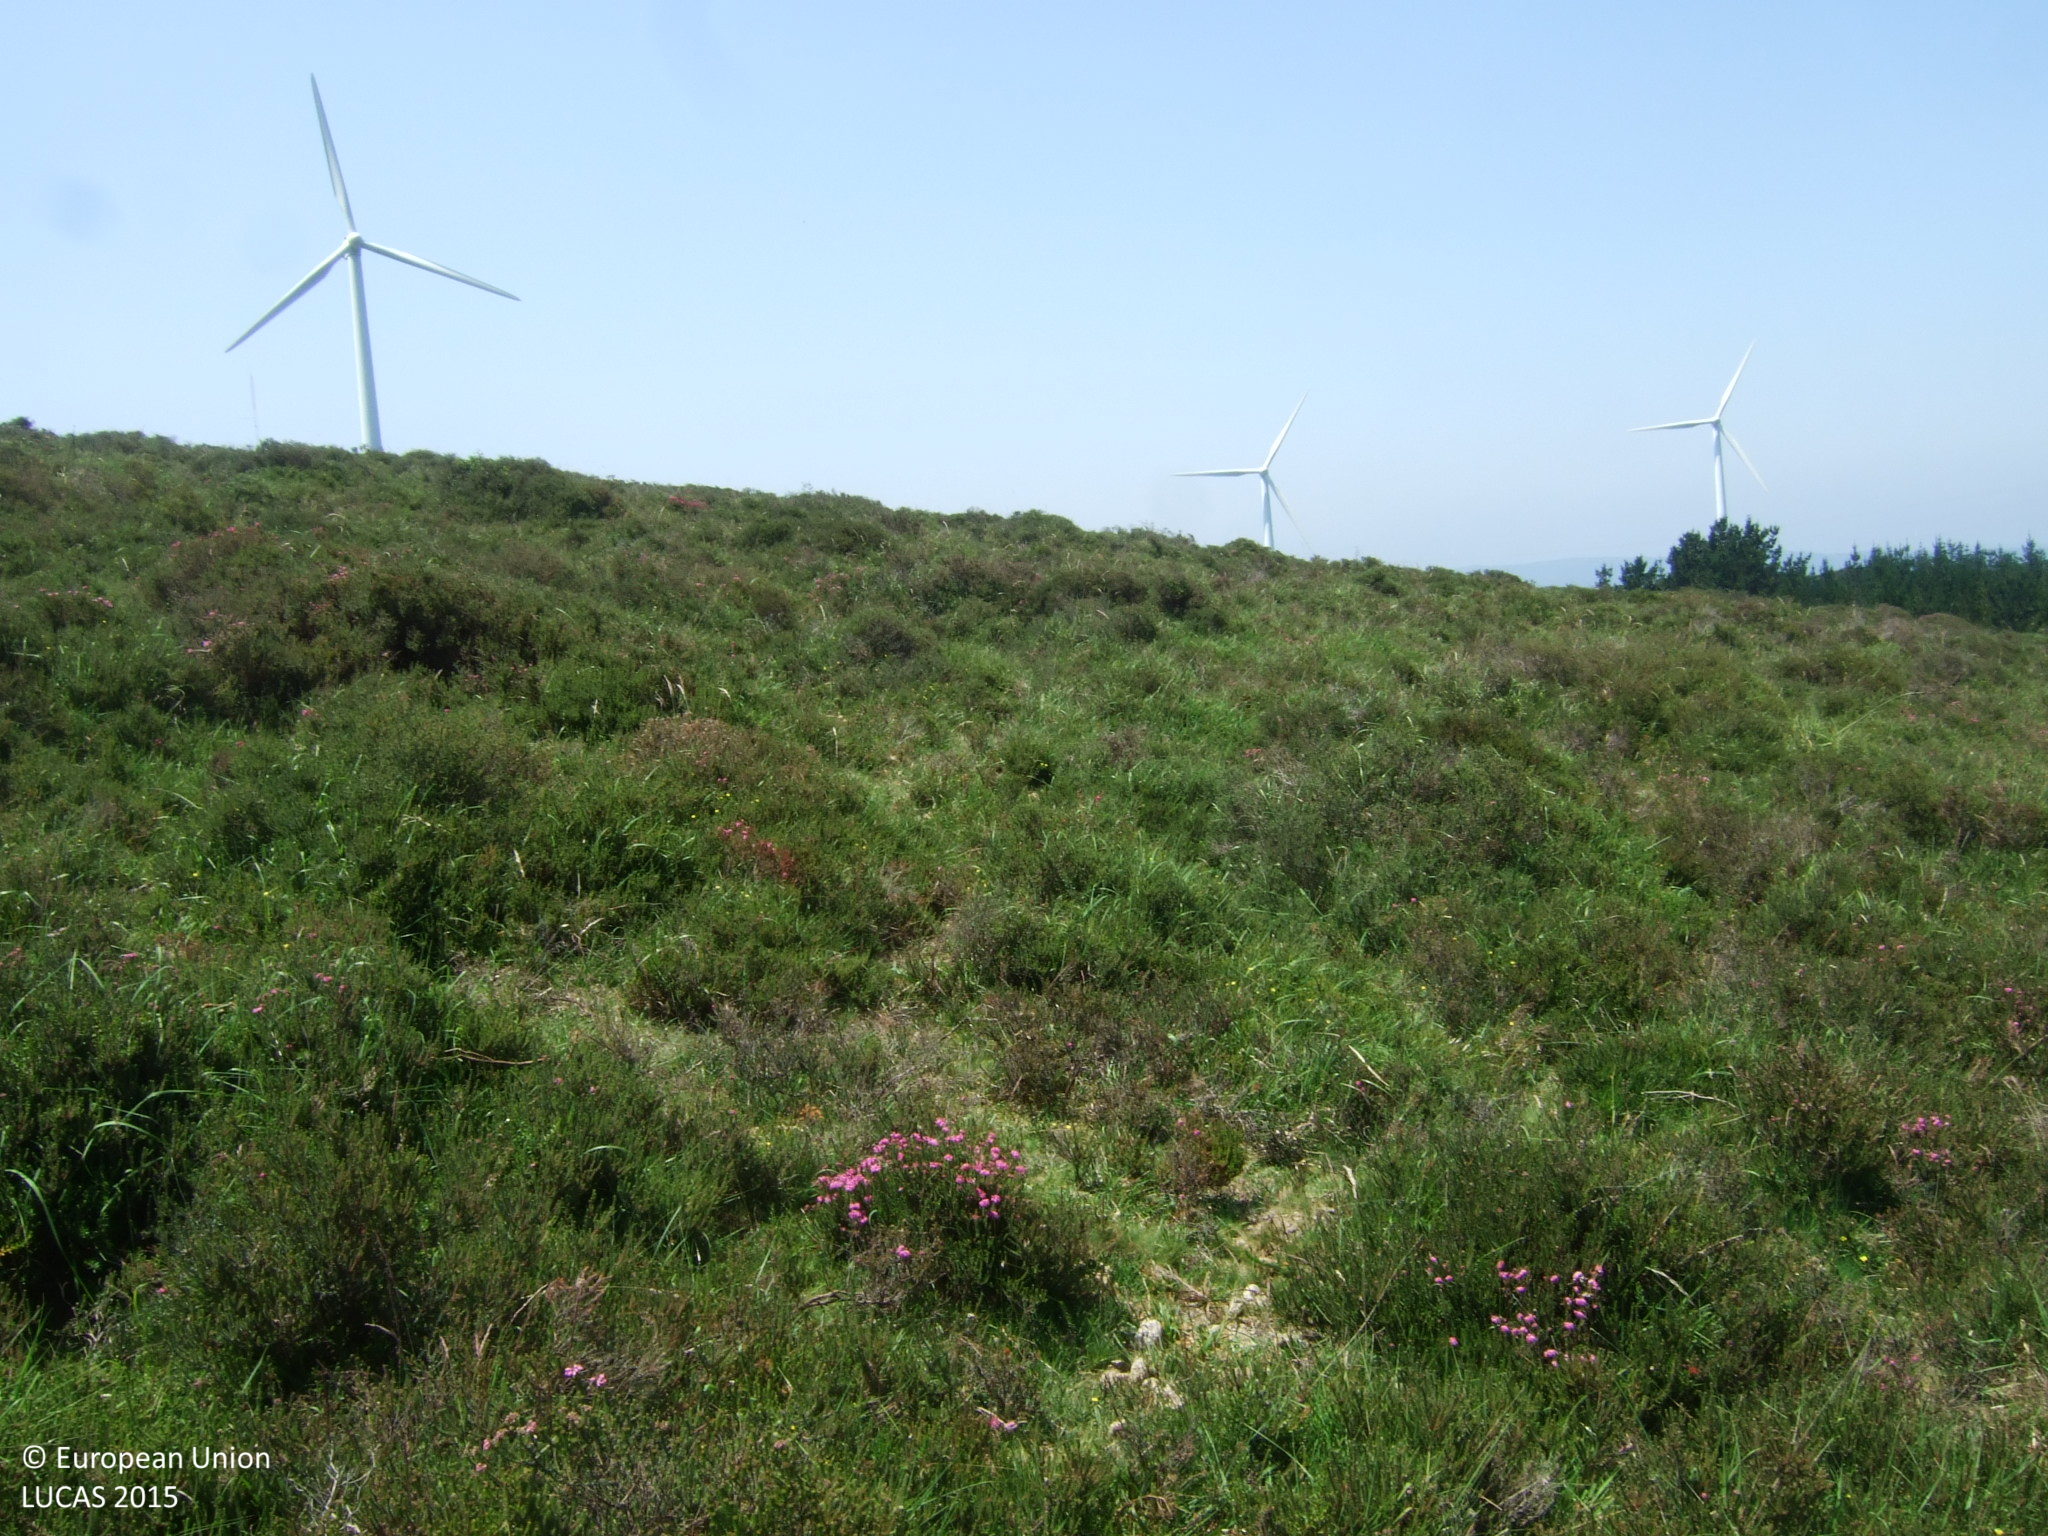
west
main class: Shrubland
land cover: Shrubland without tree cover
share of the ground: > 75 %
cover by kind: shrubs 90 %, herbaceous plants 10 %
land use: Agriculture (excluding fallow land and kitchen gardens)
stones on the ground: 10 - 25 %
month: June
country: ES
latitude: 43.5589
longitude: -7.5512
